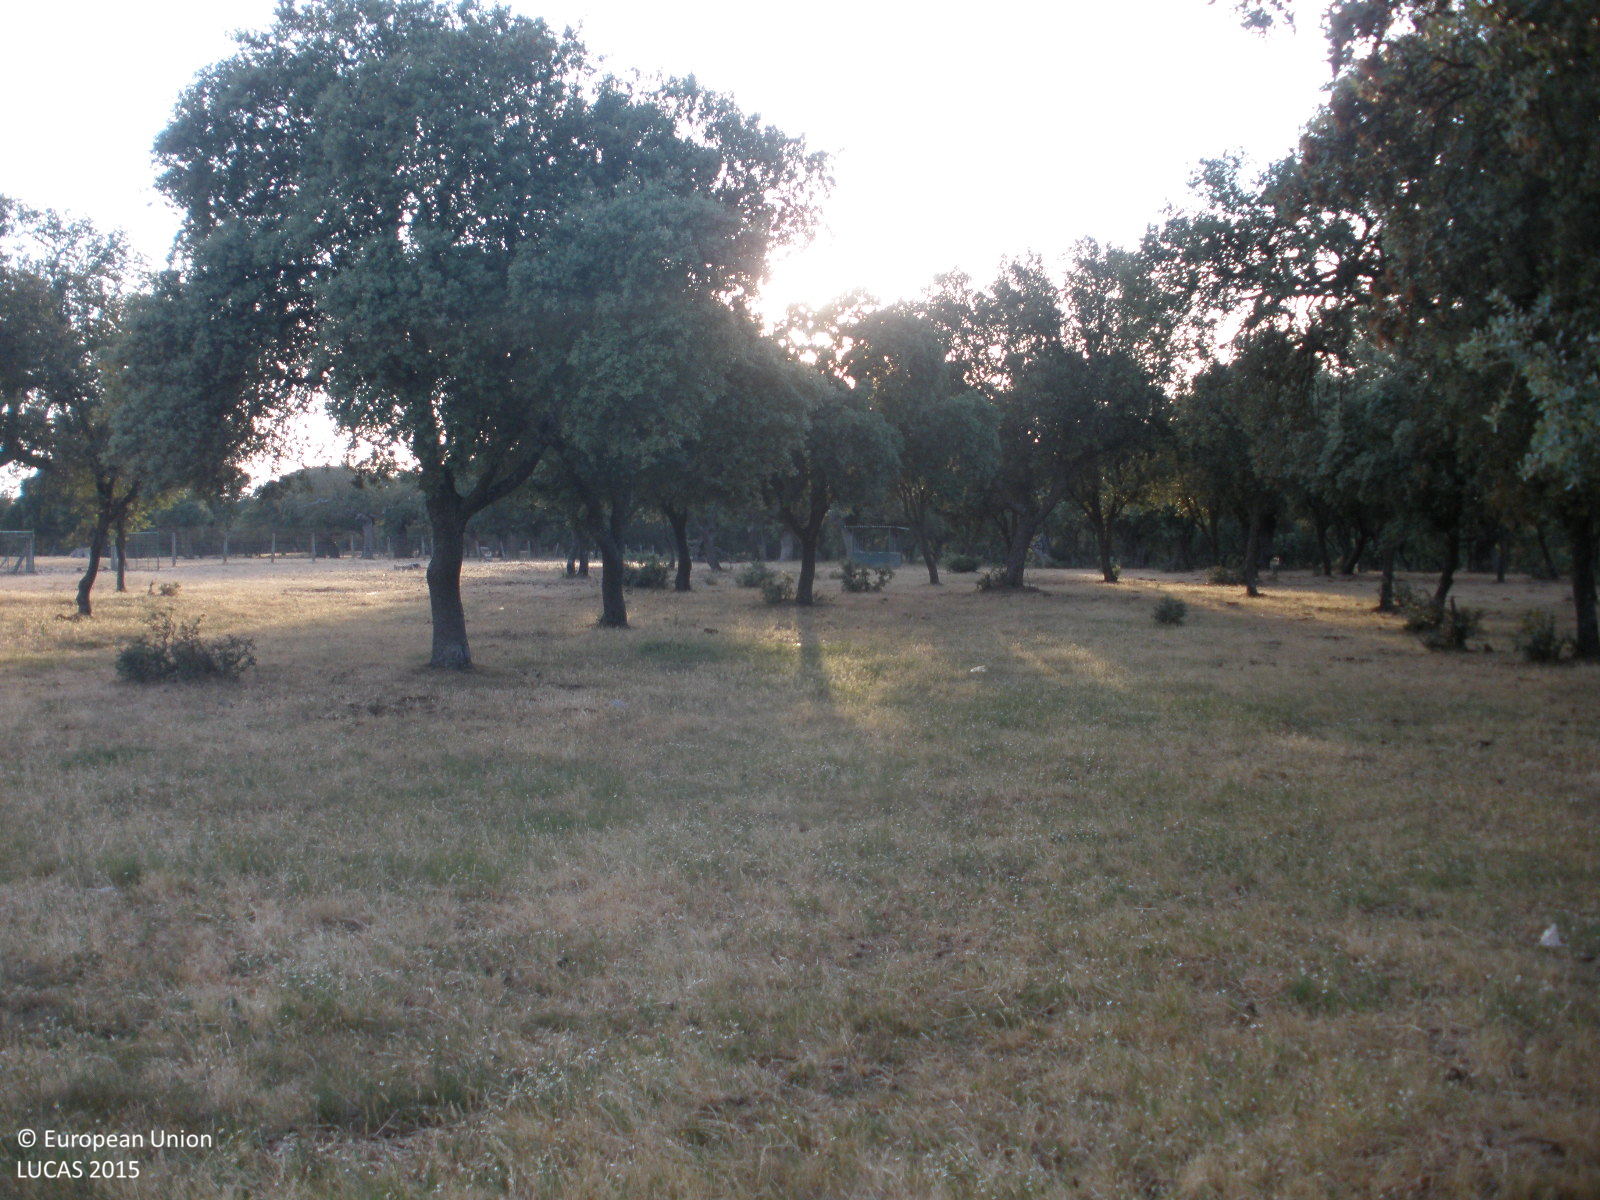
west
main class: Woodland
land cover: Broadleaved woodland
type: broadleaved evergreen forest
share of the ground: 50 - 75 %
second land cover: Grassland without tree/shrub cover
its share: > 75 %
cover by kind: broadleaved forest trees 50 %, herbaceous plants 50 %
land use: Forestry
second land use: Agriculture (excluding fallow land and kitchen gardens)
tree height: > 5 m
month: June
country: ES
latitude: 40.6253
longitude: -6.7278
